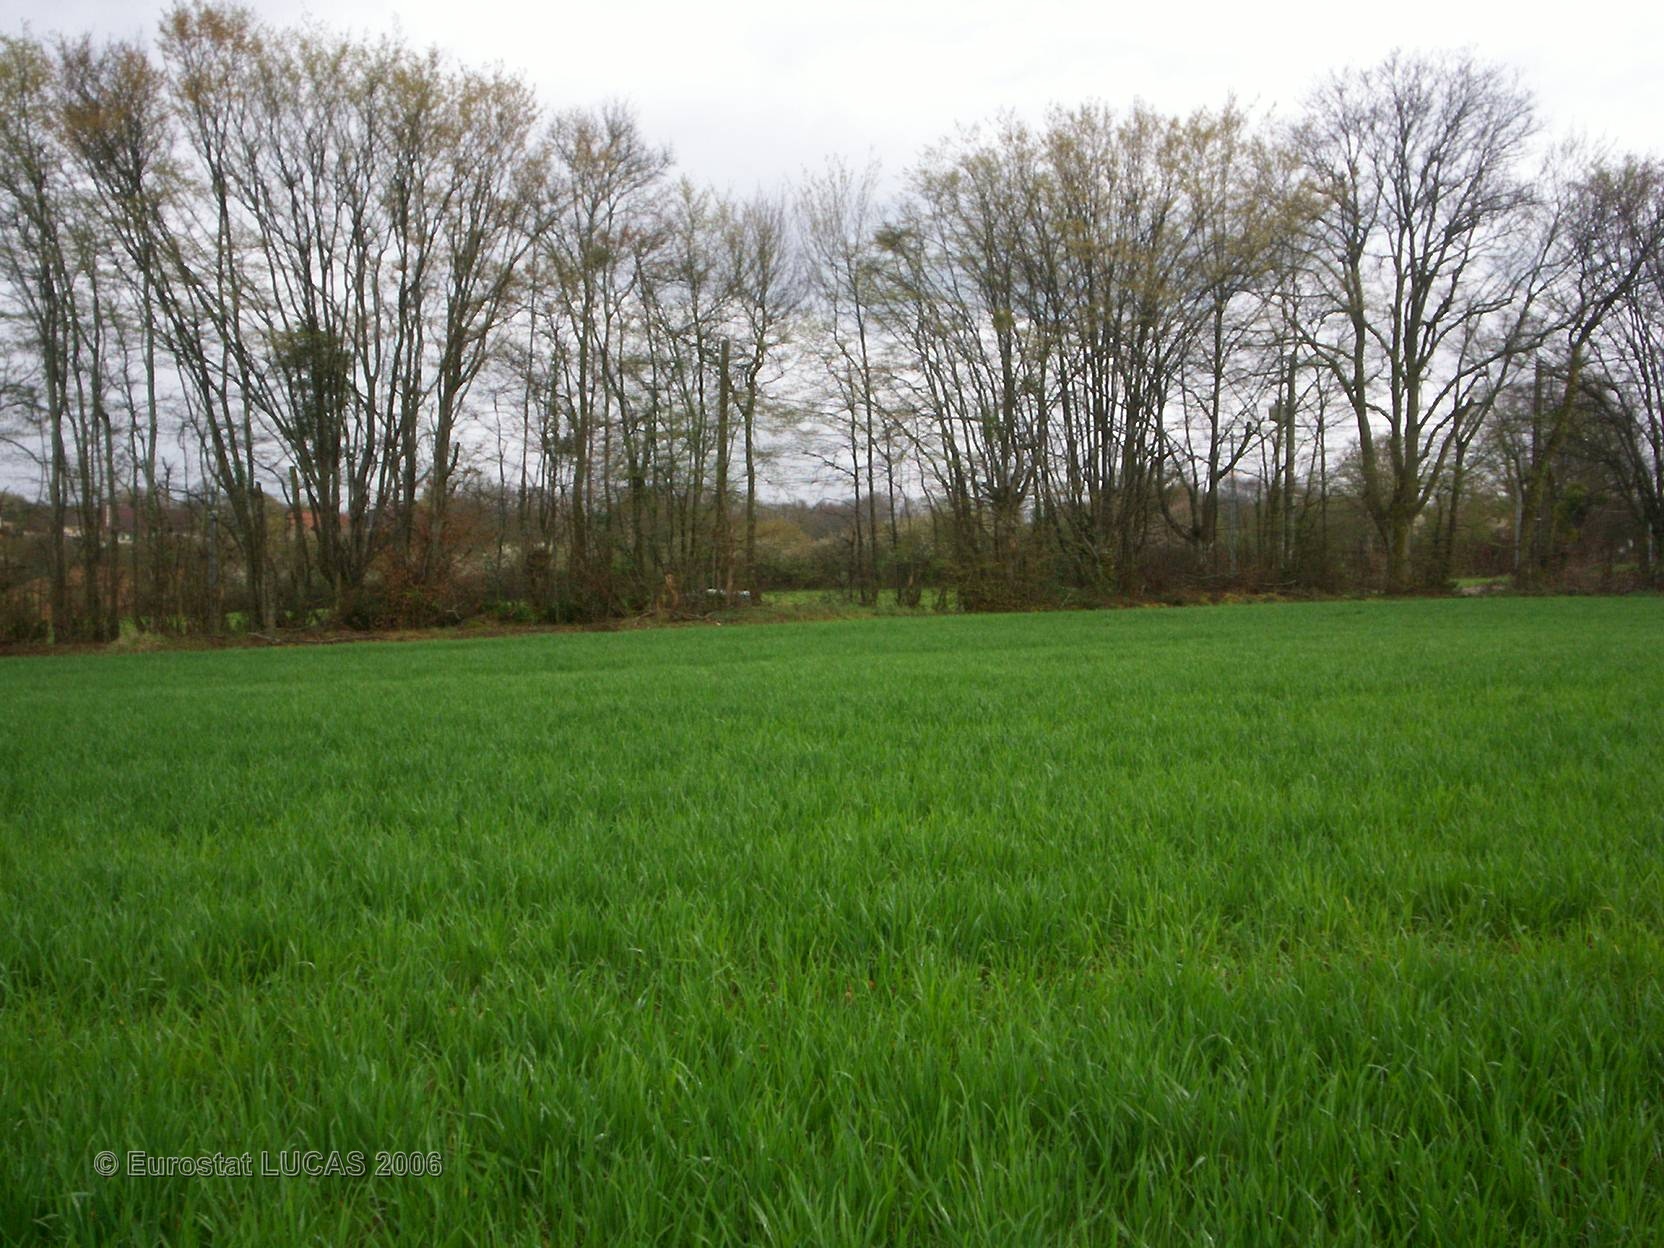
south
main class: Cropland
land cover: Barley
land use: Agriculture (excluding fallow land and kitchen gardens)
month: April
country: FR
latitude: 47.5147
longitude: 3.0229
